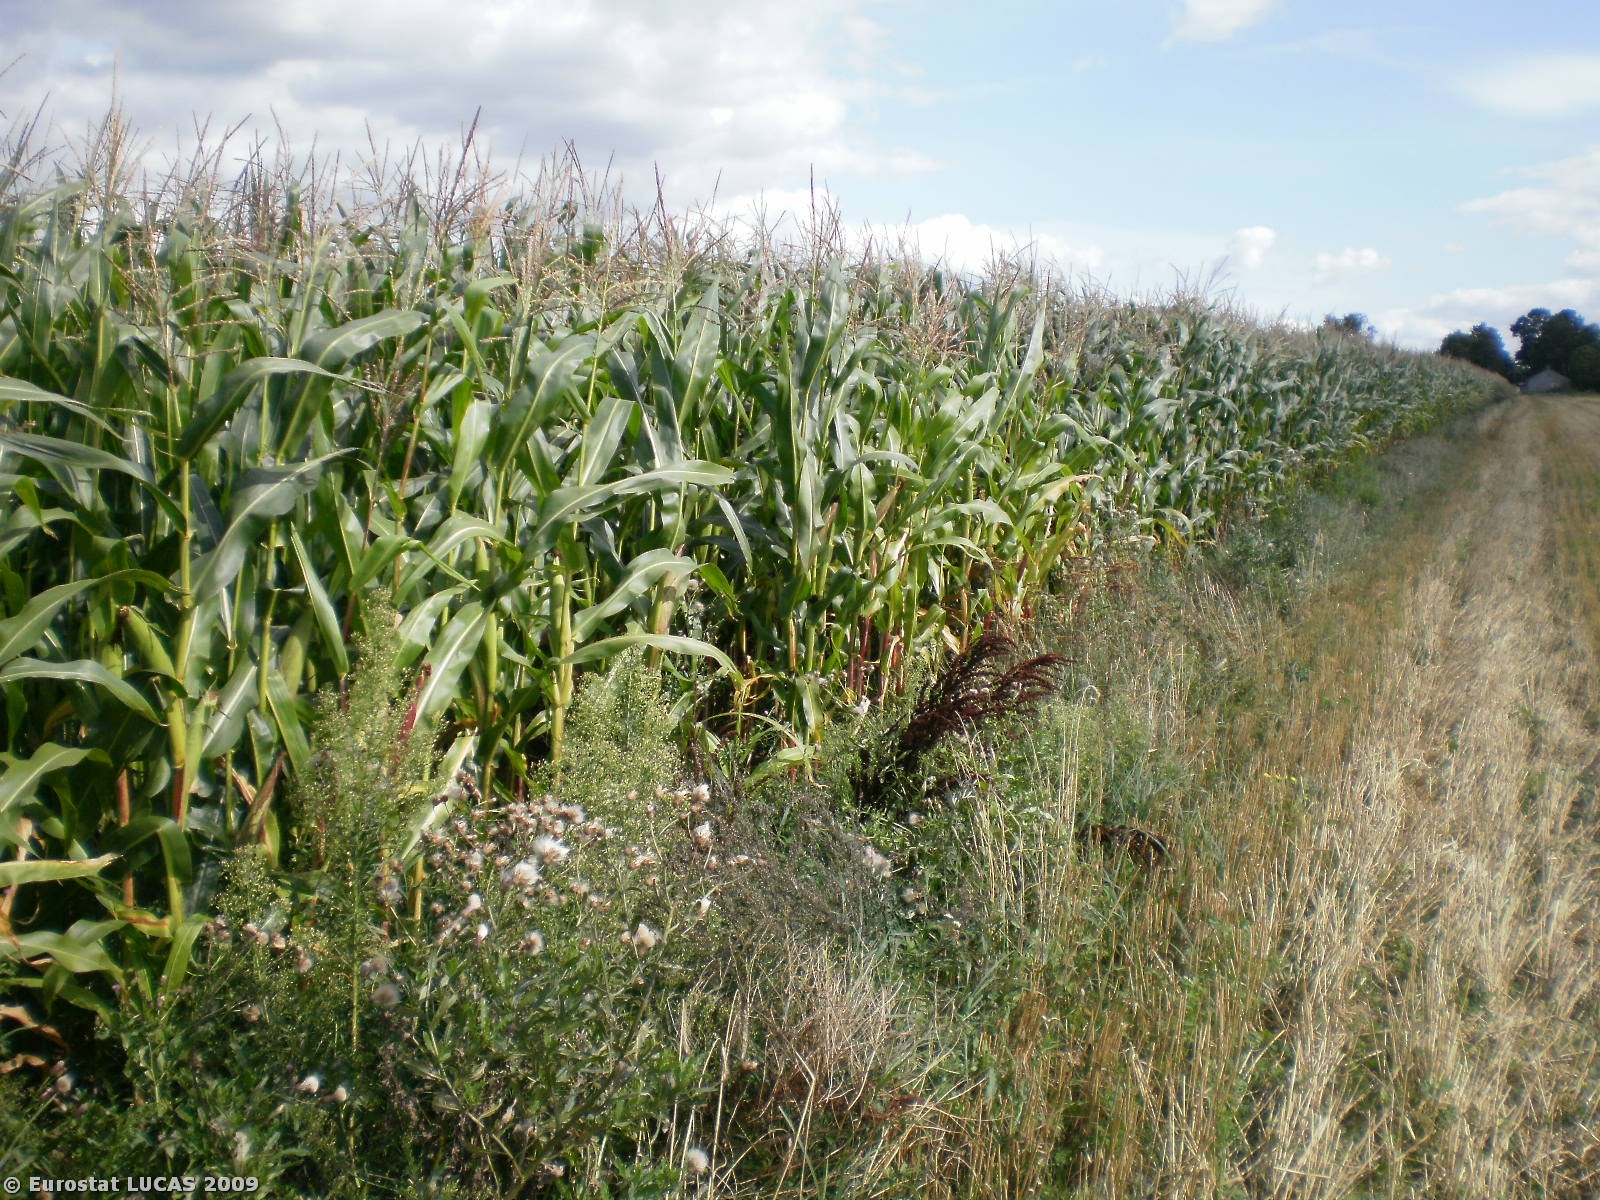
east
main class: Cropland
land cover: Maize
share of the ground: > 75 %
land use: Agriculture (excluding fallow land and kitchen gardens)
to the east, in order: Maize
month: August
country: PL
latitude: 52.5486
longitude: 22.3481
